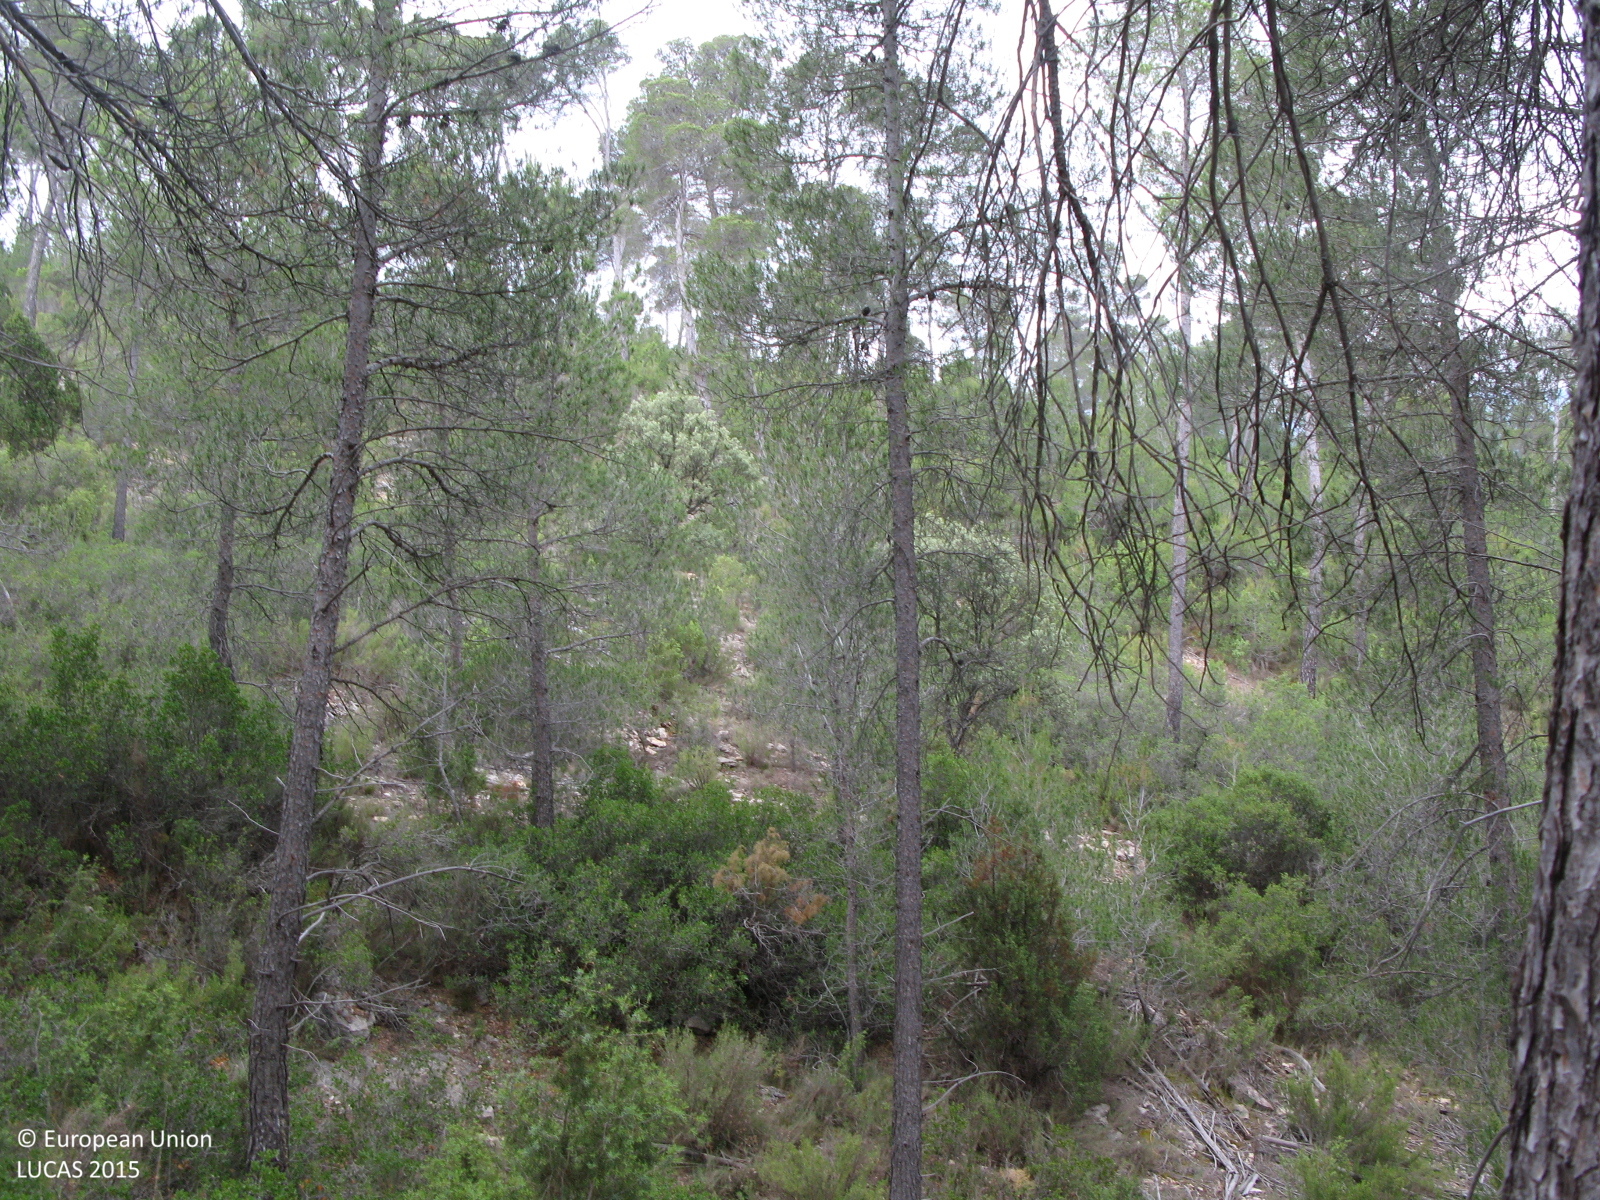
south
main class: Woodland
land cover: Pine dominated coniferous woodland
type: coniferous forest of the mediterranean region
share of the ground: 50 - 75 %
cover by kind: coniferous forest trees 50 %, shrubs 30 %, herbaceous plants 15 %, consolidated bare surface 5 %
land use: Forestry
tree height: > 5 m
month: June
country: ES
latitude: 39.8852
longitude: -1.1501
